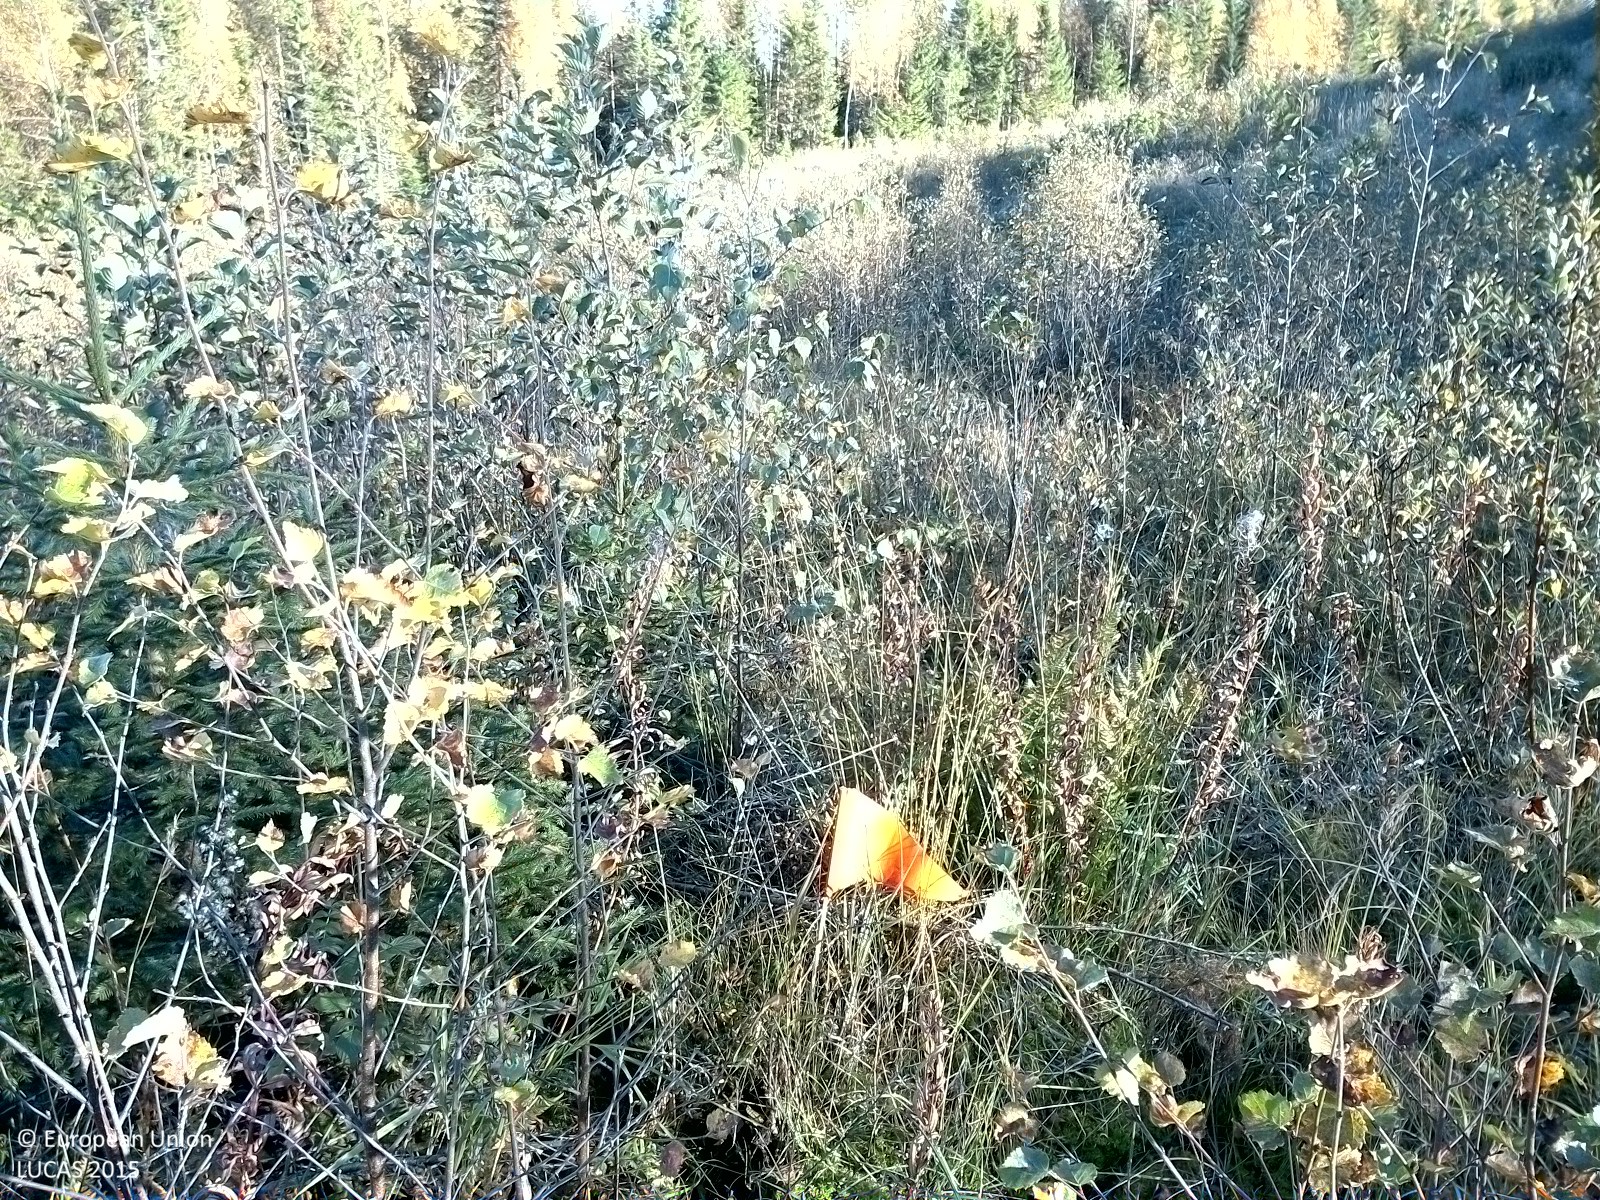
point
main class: Artificial land
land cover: Other artificial areas
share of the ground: > 75 %
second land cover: Broadleaved woodland
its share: > 75 %
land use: Electricity, gas and thermal power distribution
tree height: < 5 m
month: September
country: SE
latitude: 62.3987
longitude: 16.9255
